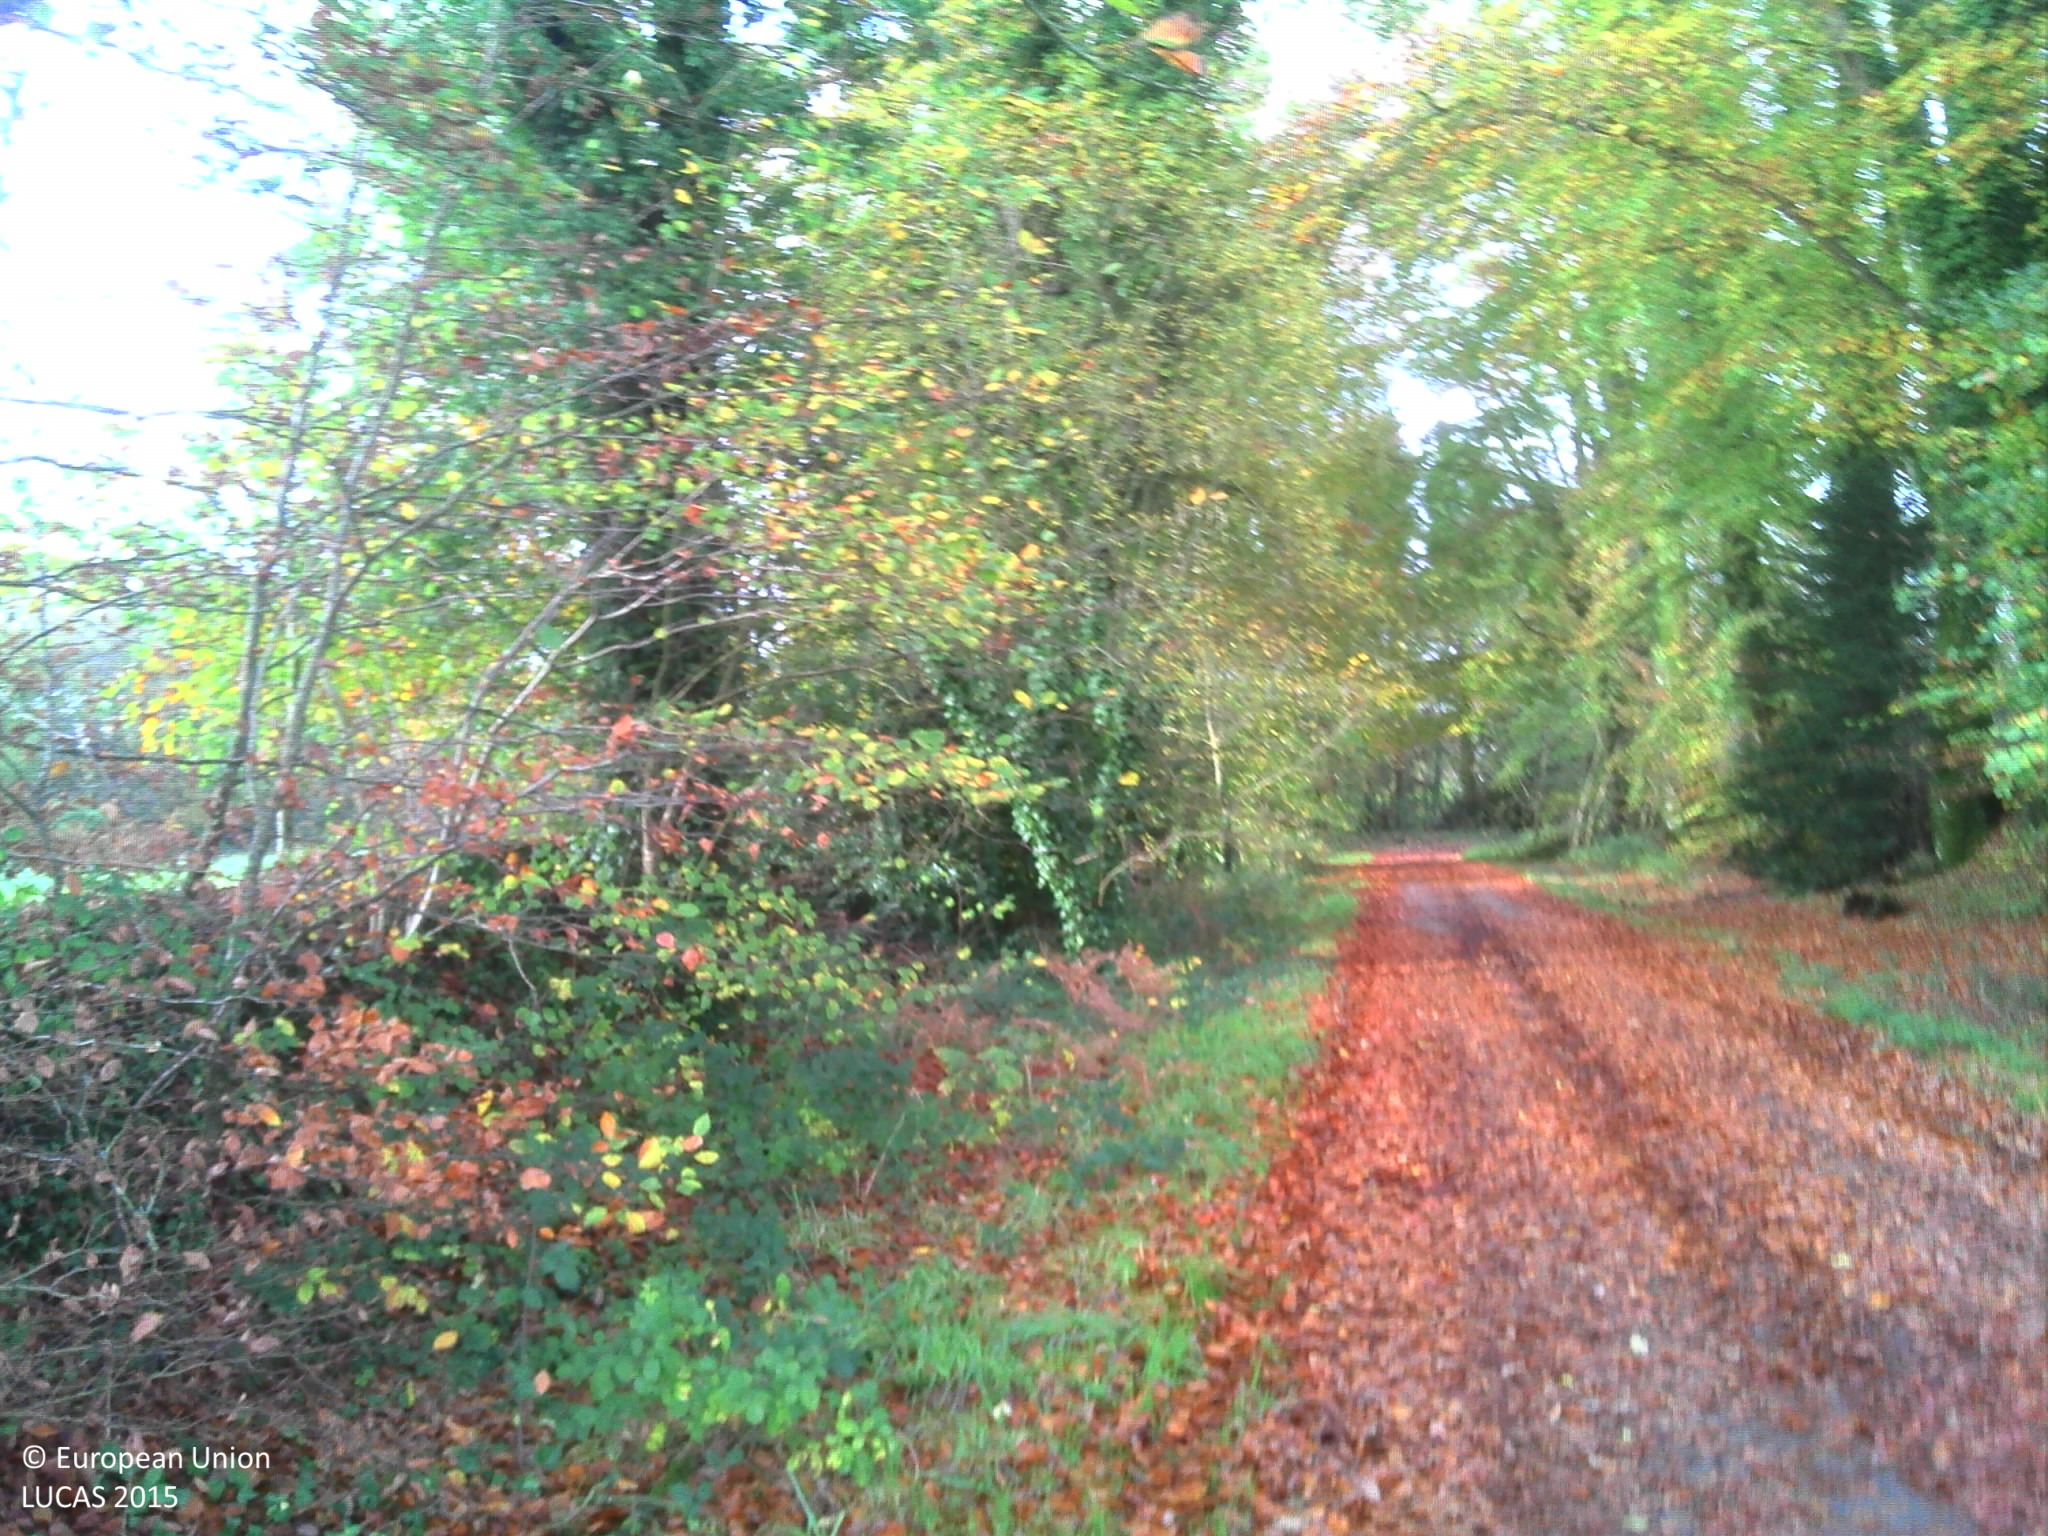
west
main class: Woodland
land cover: Broadleaved woodland
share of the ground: > 75 %
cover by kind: broadleaved forest trees 100 %
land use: Agriculture (excluding fallow land and kitchen gardens)
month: November
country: FR
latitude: 48.0658
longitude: -3.1822
